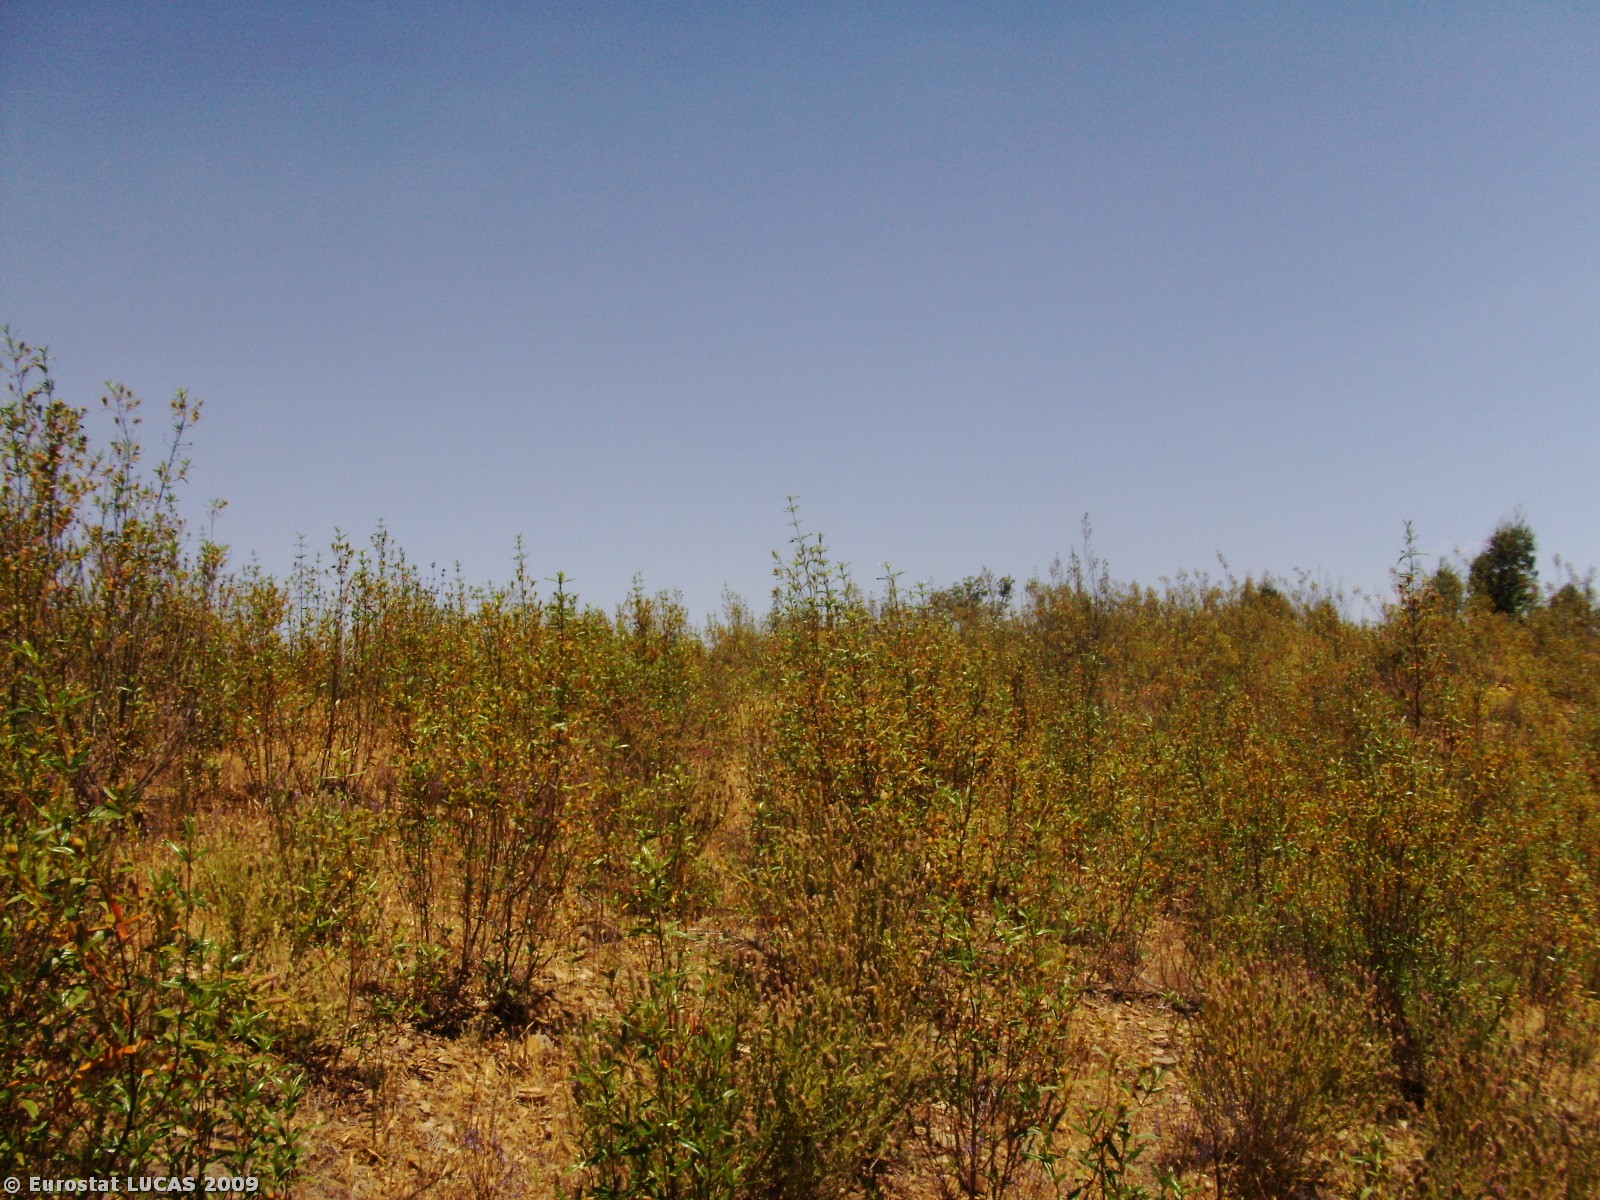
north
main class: Shrubland
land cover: Shrubland without tree cover
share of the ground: 50 - 75 %
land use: Unused
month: May
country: PT
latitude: 37.4676
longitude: -8.2404
